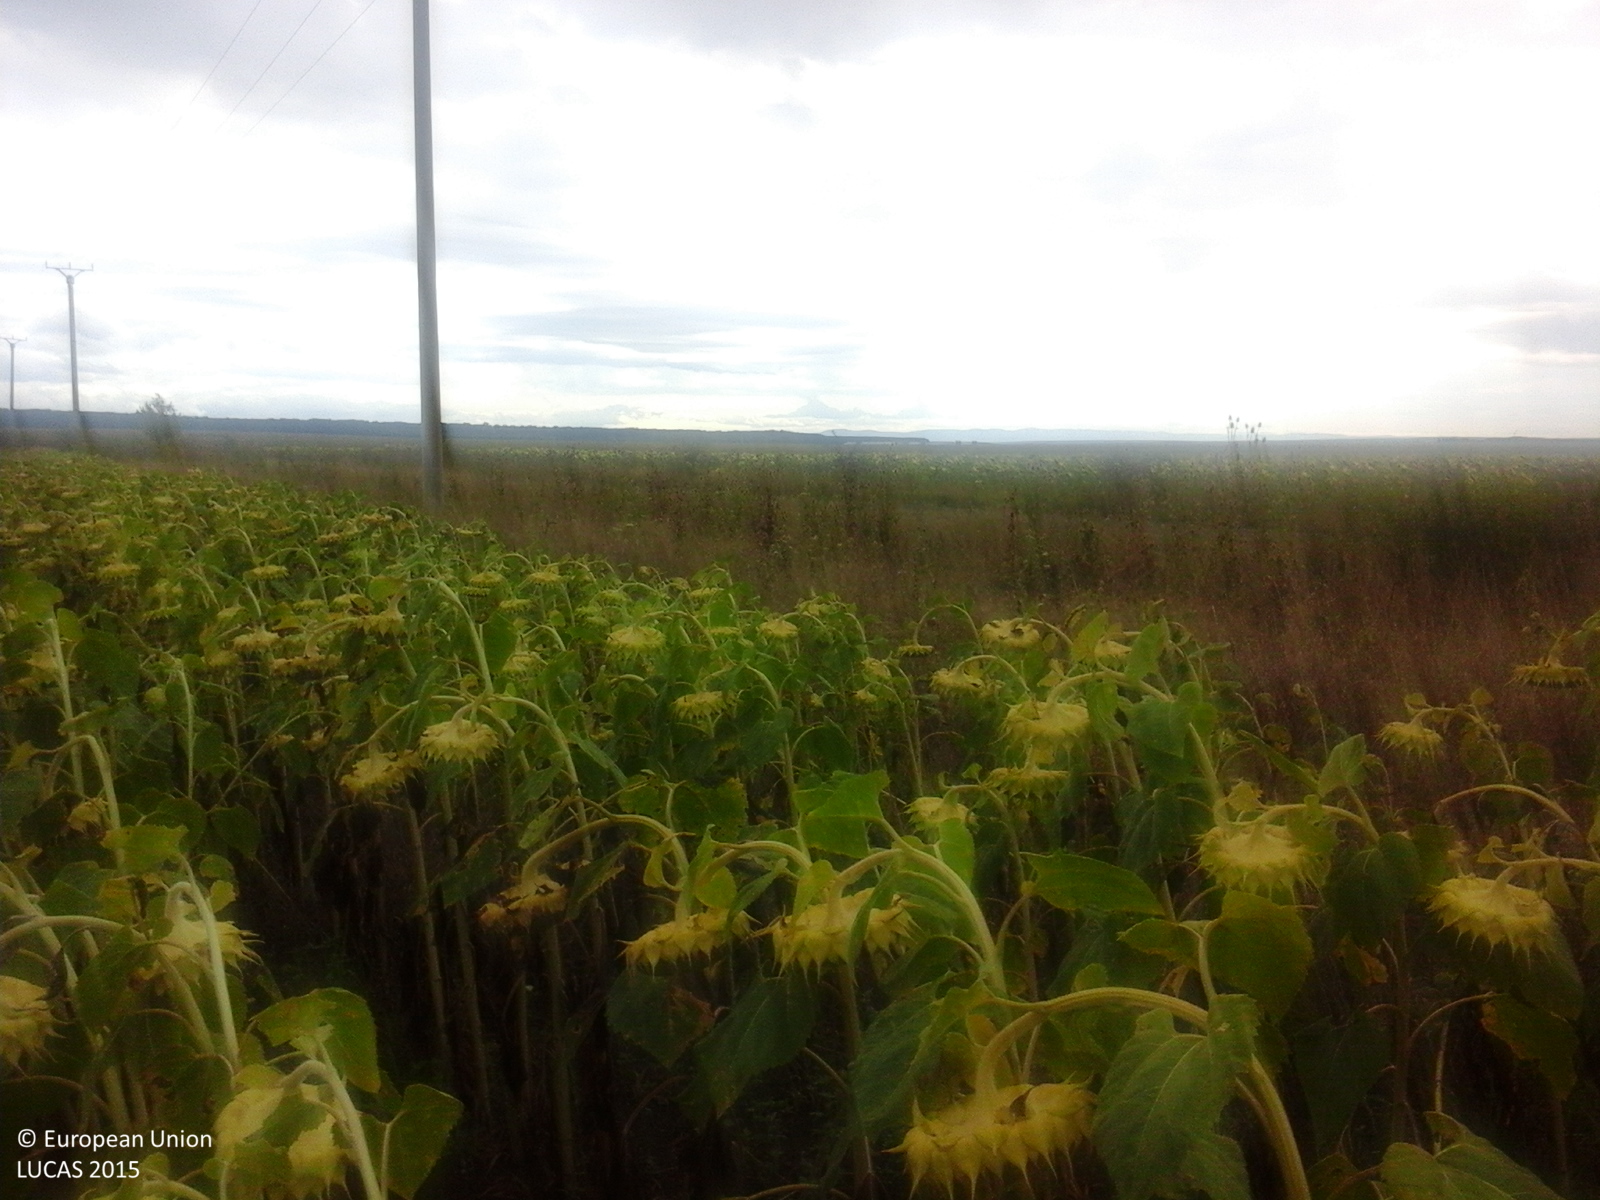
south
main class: Cropland
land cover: Sunflower
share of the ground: > 75 %
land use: Agriculture (excluding fallow land and kitchen gardens)
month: August
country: RO
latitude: 45.5773
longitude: 21.5542
